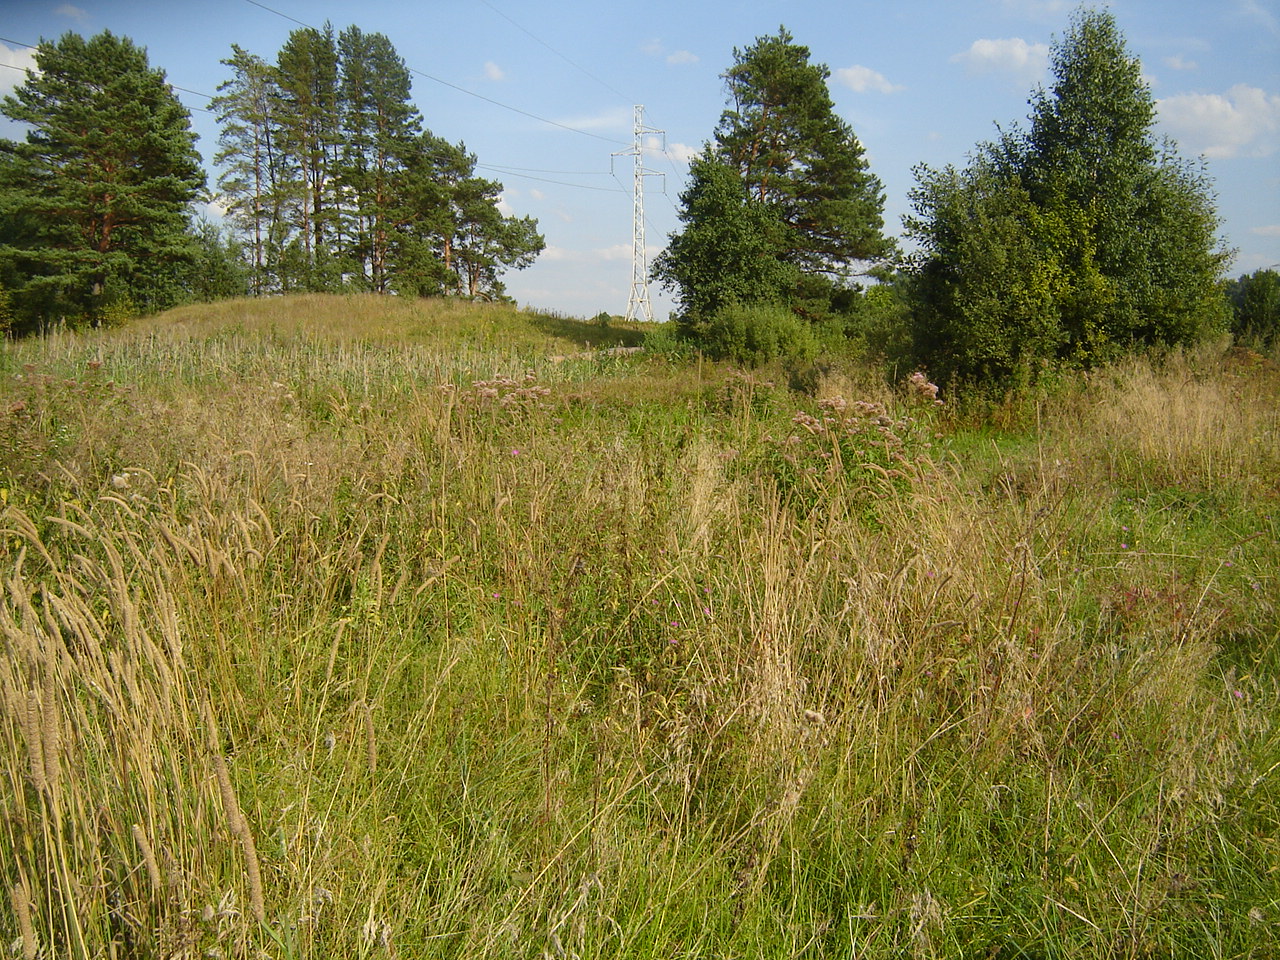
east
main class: Grassland
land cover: Spontaneously vegetated surfaces
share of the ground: > 75 %
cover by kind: herbaceous plants 100 %
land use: Fallow land
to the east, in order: Spontaneously vegetated surfaces; Pine dominated mixed woodland; Spontaneously vegetated surfaces; Pine dominated mixed woodland; Spontaneously vegetated surfaces; Pine dominated mixed woodland; Spontaneously vegetated surfaces
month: August
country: LT
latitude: 54.7586
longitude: 24.9216
